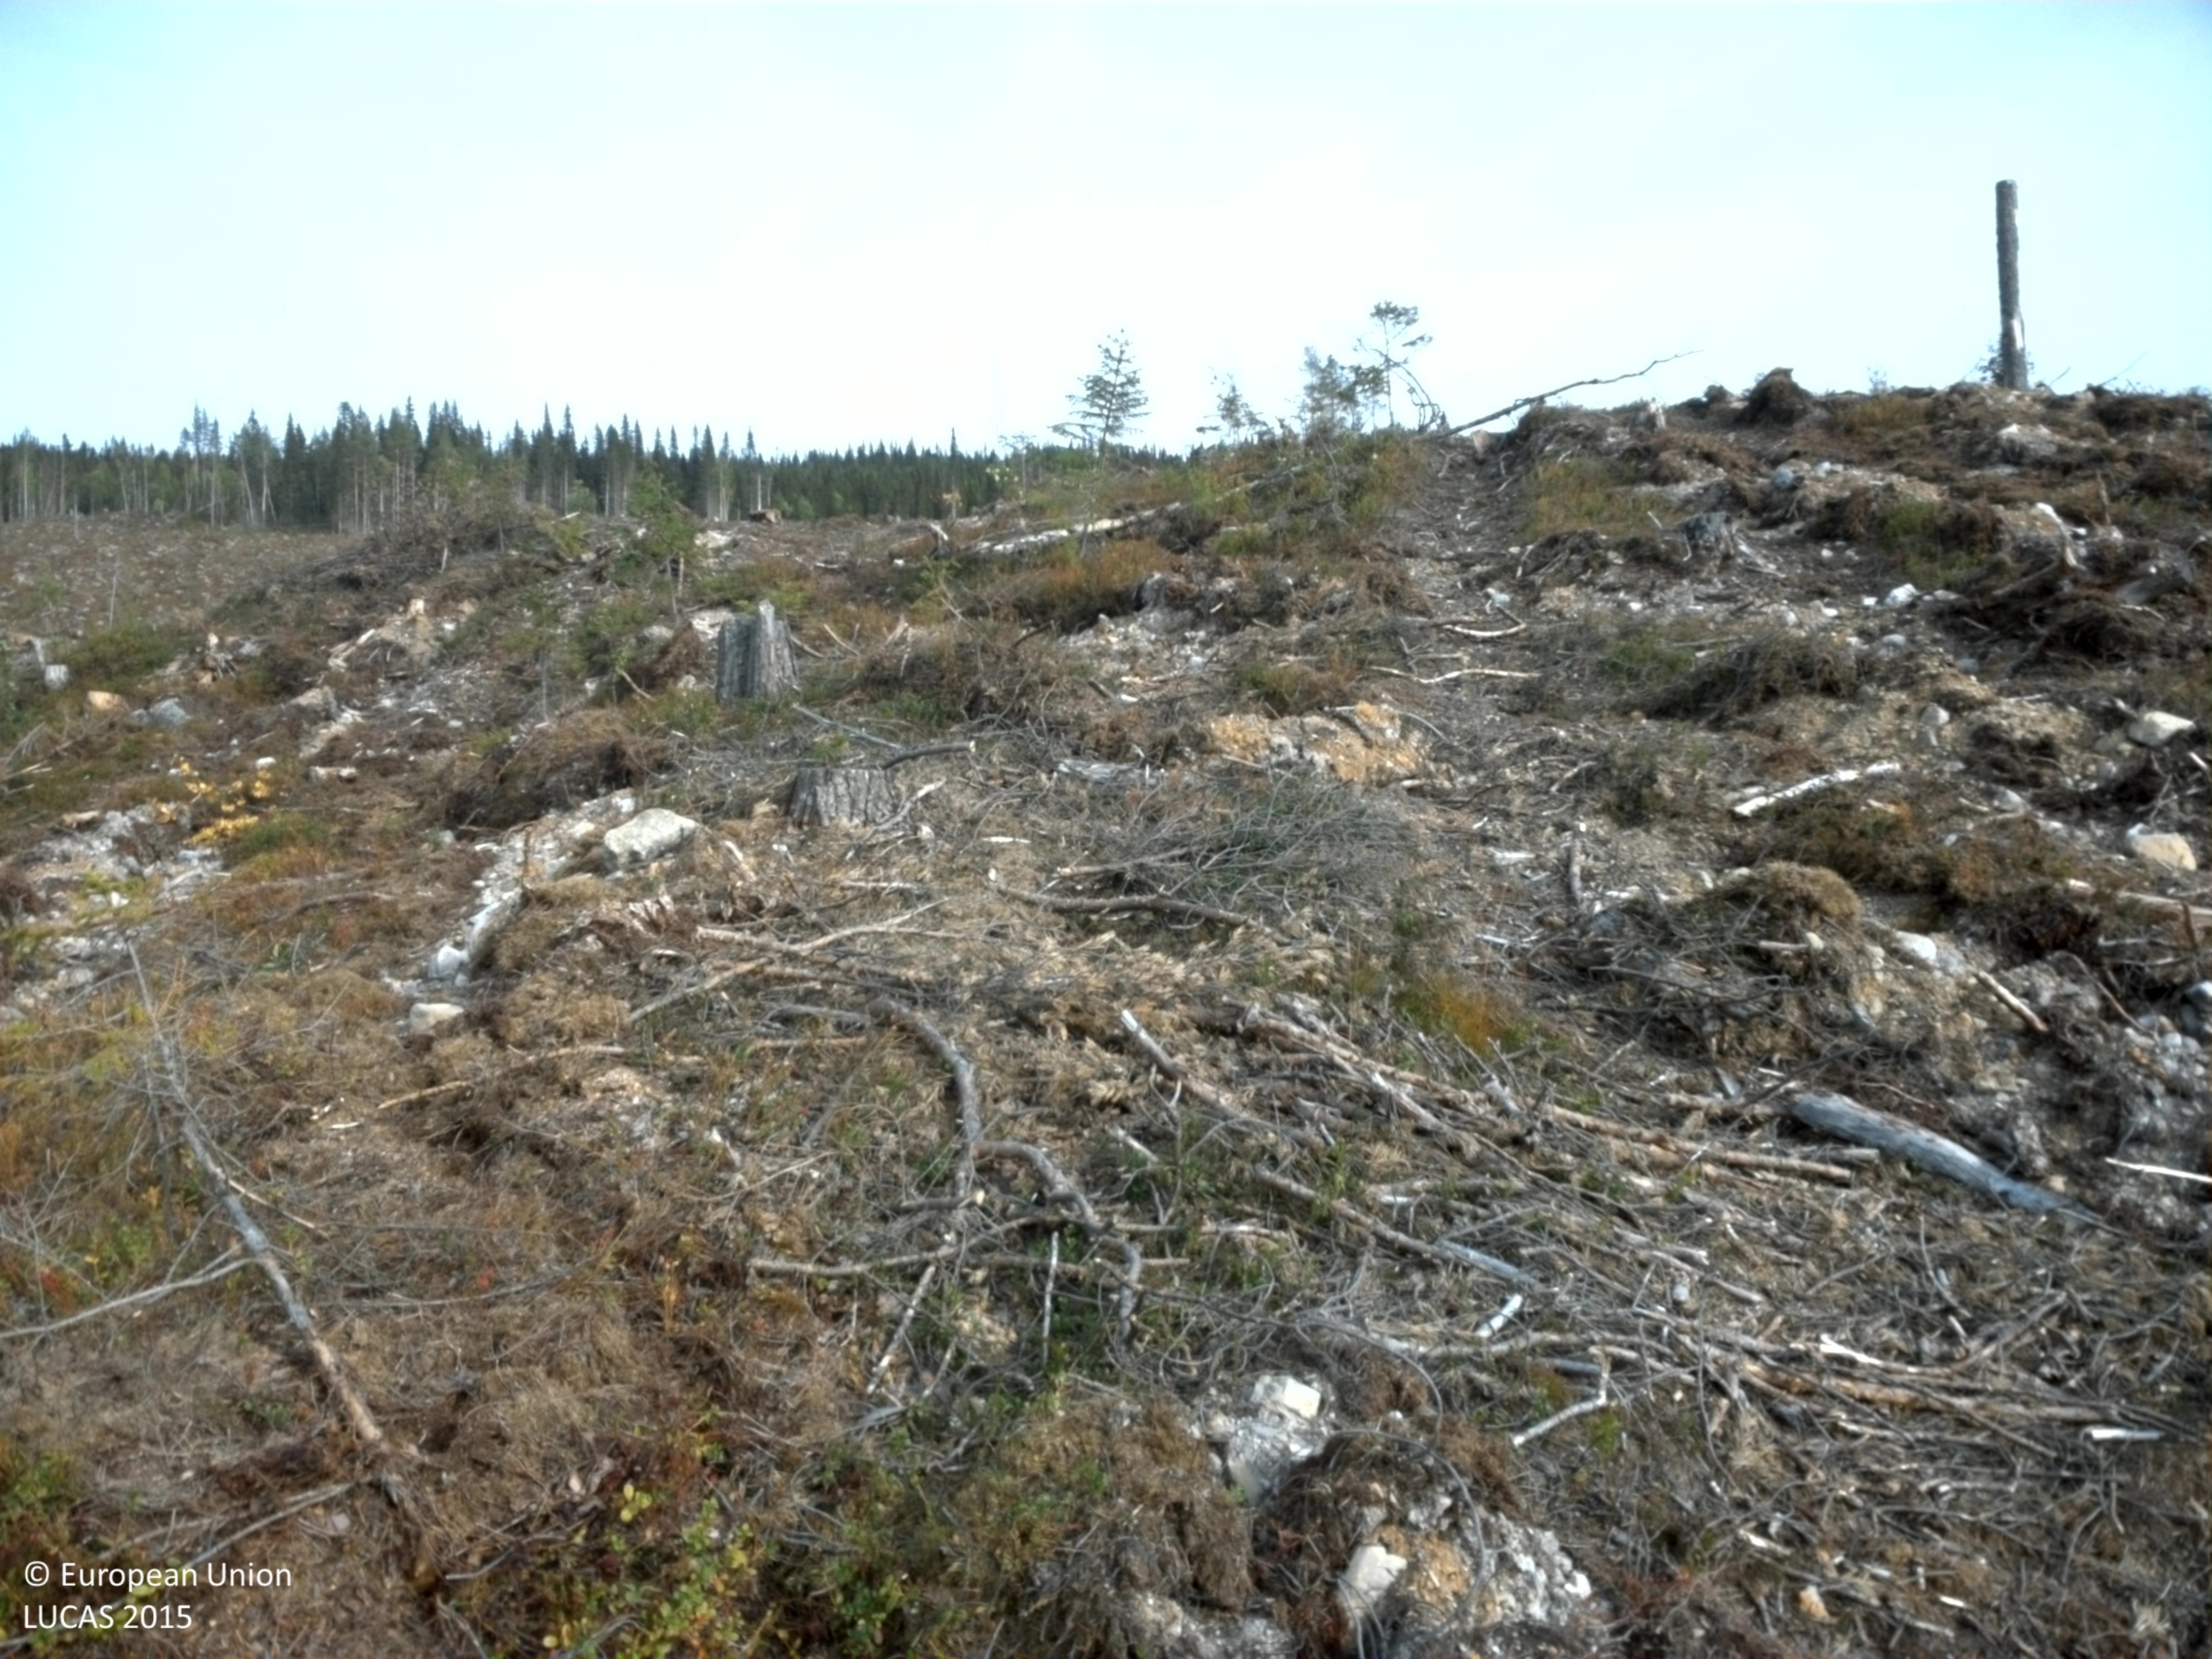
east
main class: Shrubland
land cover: Shrubland with sparse tree cover
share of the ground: 10 - 25 %
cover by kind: unconsolidated bare surface 55 %, shrubs 20 %, coniferous forest trees 5 %, herbaceous plants 5 %, lichens and mosses 5 %, consolidated bare surface 5 %
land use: Forestry
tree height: < 5 m
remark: Clear cut
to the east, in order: Shrubland with sparse tree cover; Shrubland without tree cover; Shrubland with sparse tree cover; Shrubland without tree cover; Grassland with sparse tree/shrub cover
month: September
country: SE
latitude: 65.3652
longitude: 16.6486
